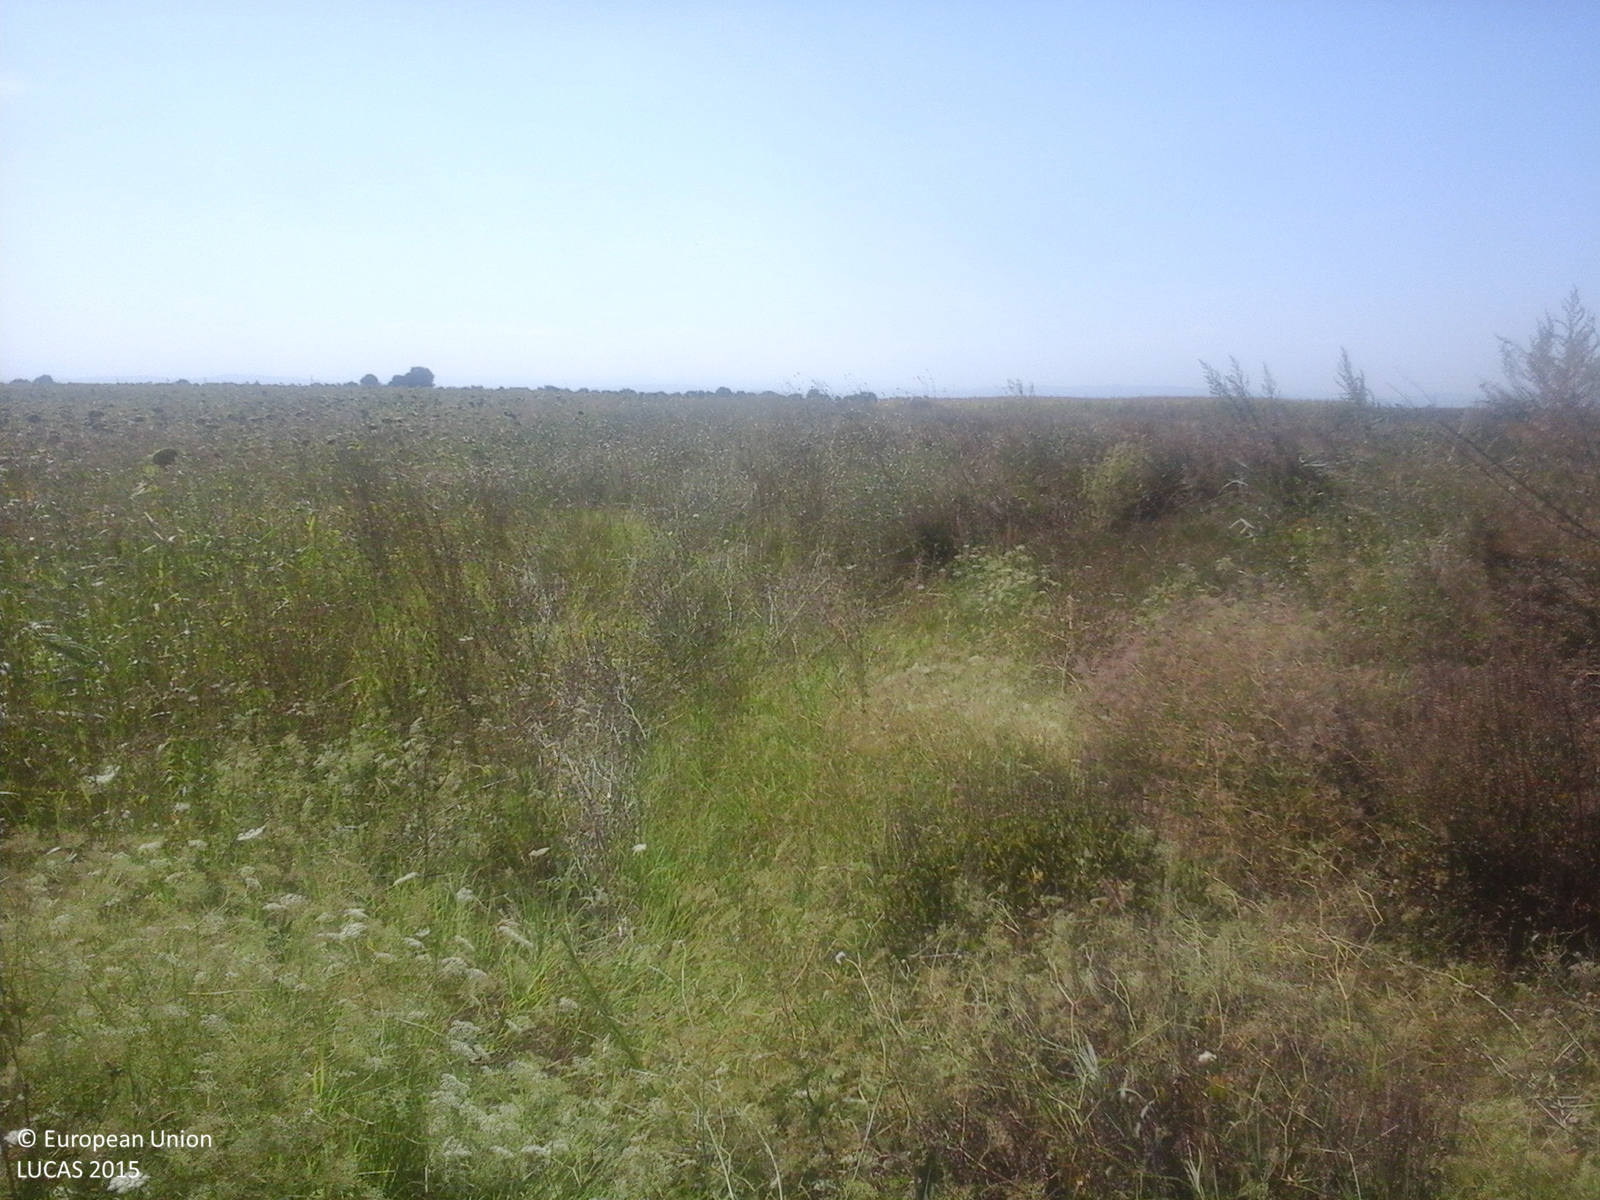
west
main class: Cropland
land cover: Sunflower
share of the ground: > 75 %
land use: Agriculture (excluding fallow land and kitchen gardens)
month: August
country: RO
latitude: 45.5632
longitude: 27.4620
